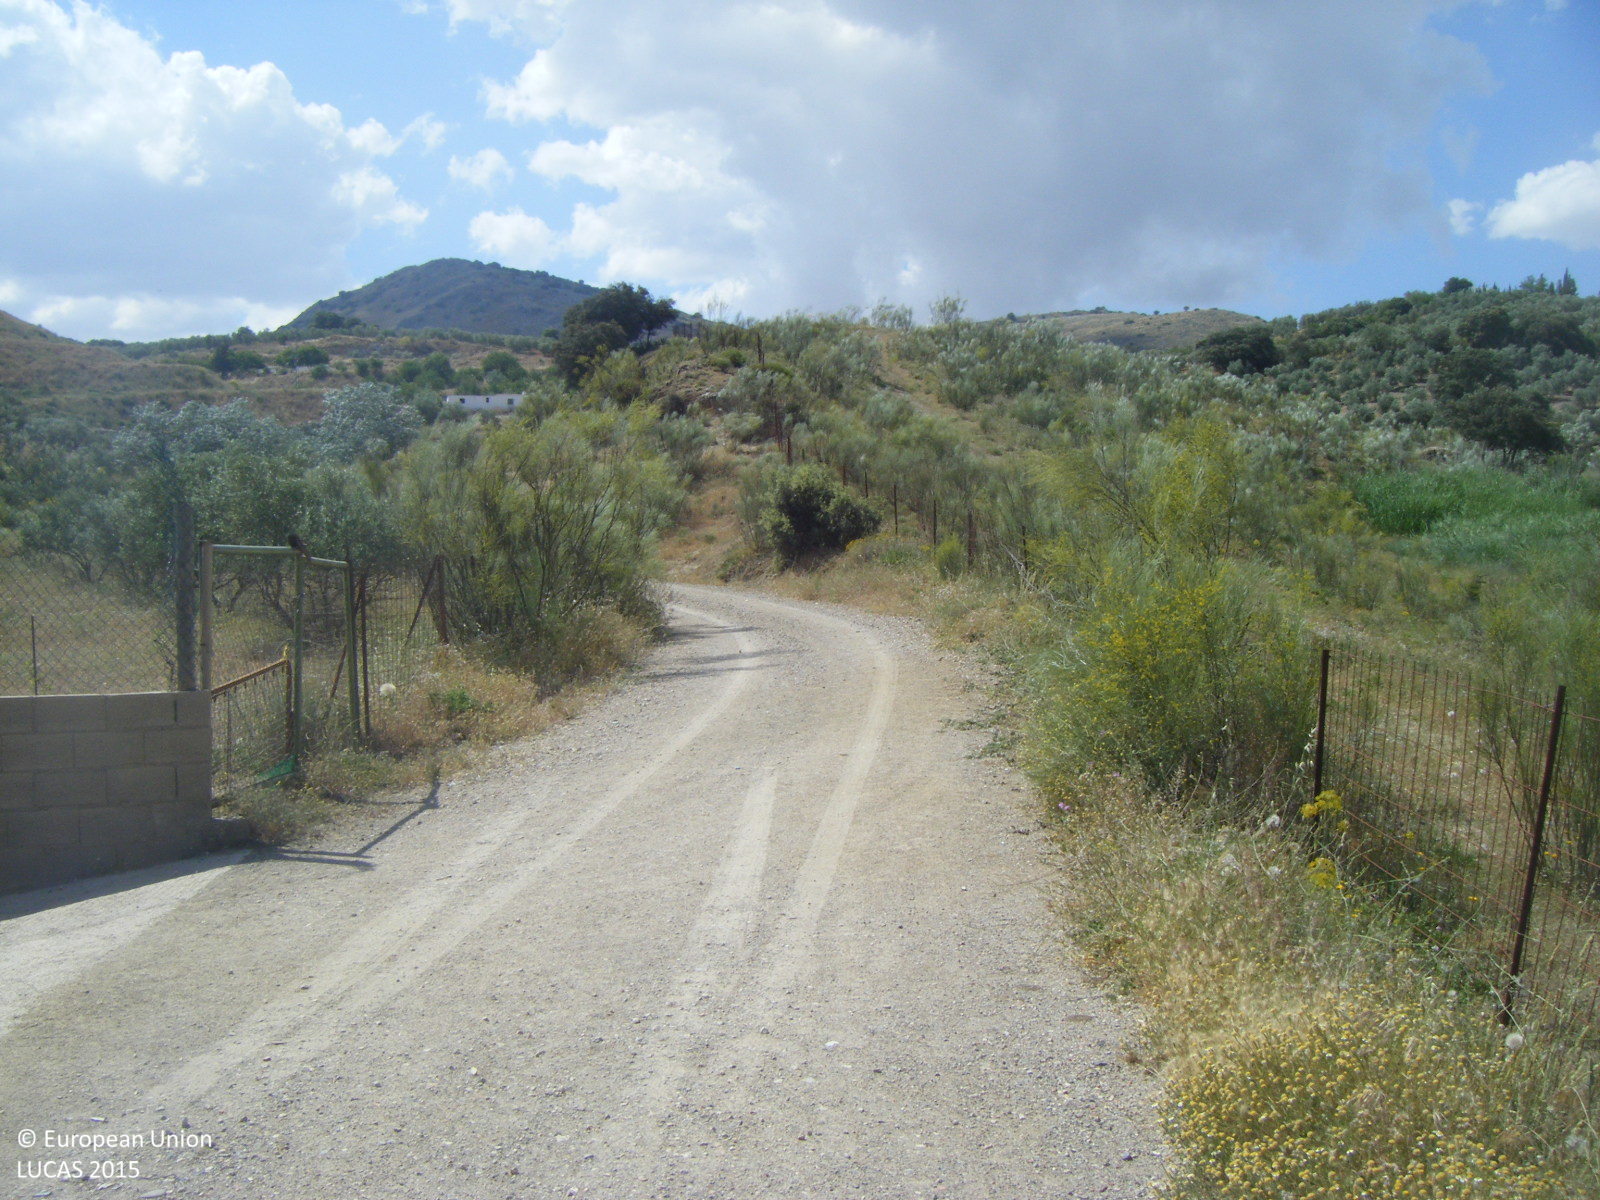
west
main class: Cropland
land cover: Olive groves
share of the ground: 10 - 25 %
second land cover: Other bare soil
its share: > 75 %
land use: Agriculture (excluding fallow land and kitchen gardens)
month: May
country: ES
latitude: 37.0924
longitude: -4.3628
